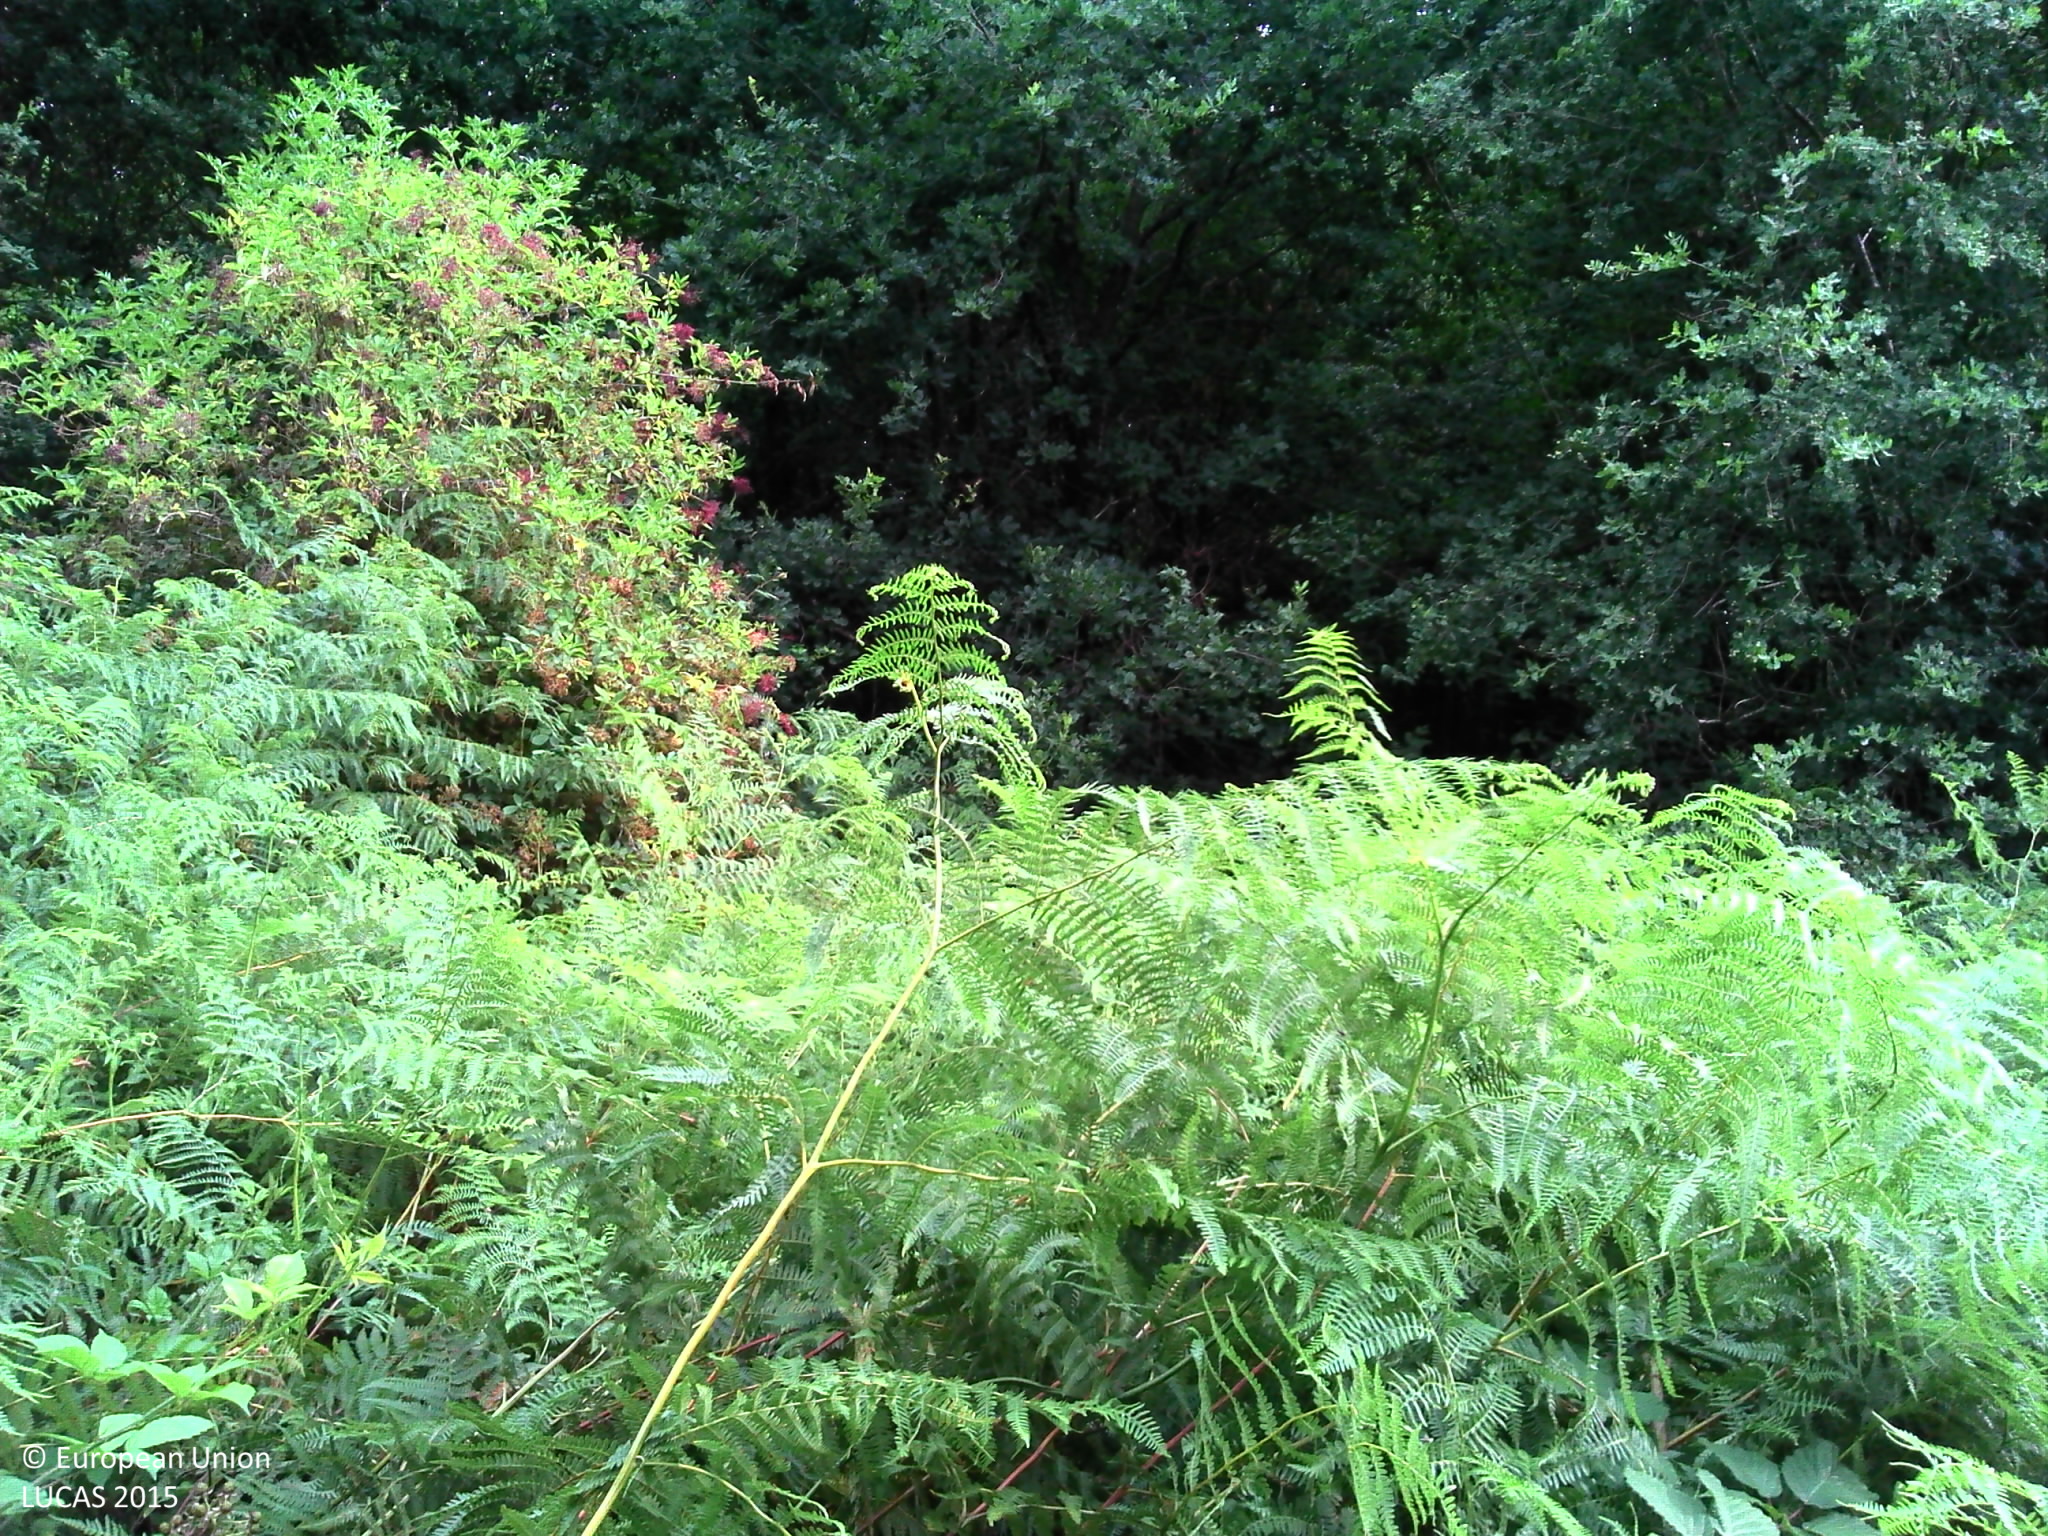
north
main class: Grassland
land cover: Spontaneously vegetated surfaces
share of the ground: > 75 %
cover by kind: herbaceous plants 95 %
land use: Forestry
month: July
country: FR
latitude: 45.7639
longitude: 1.3382
